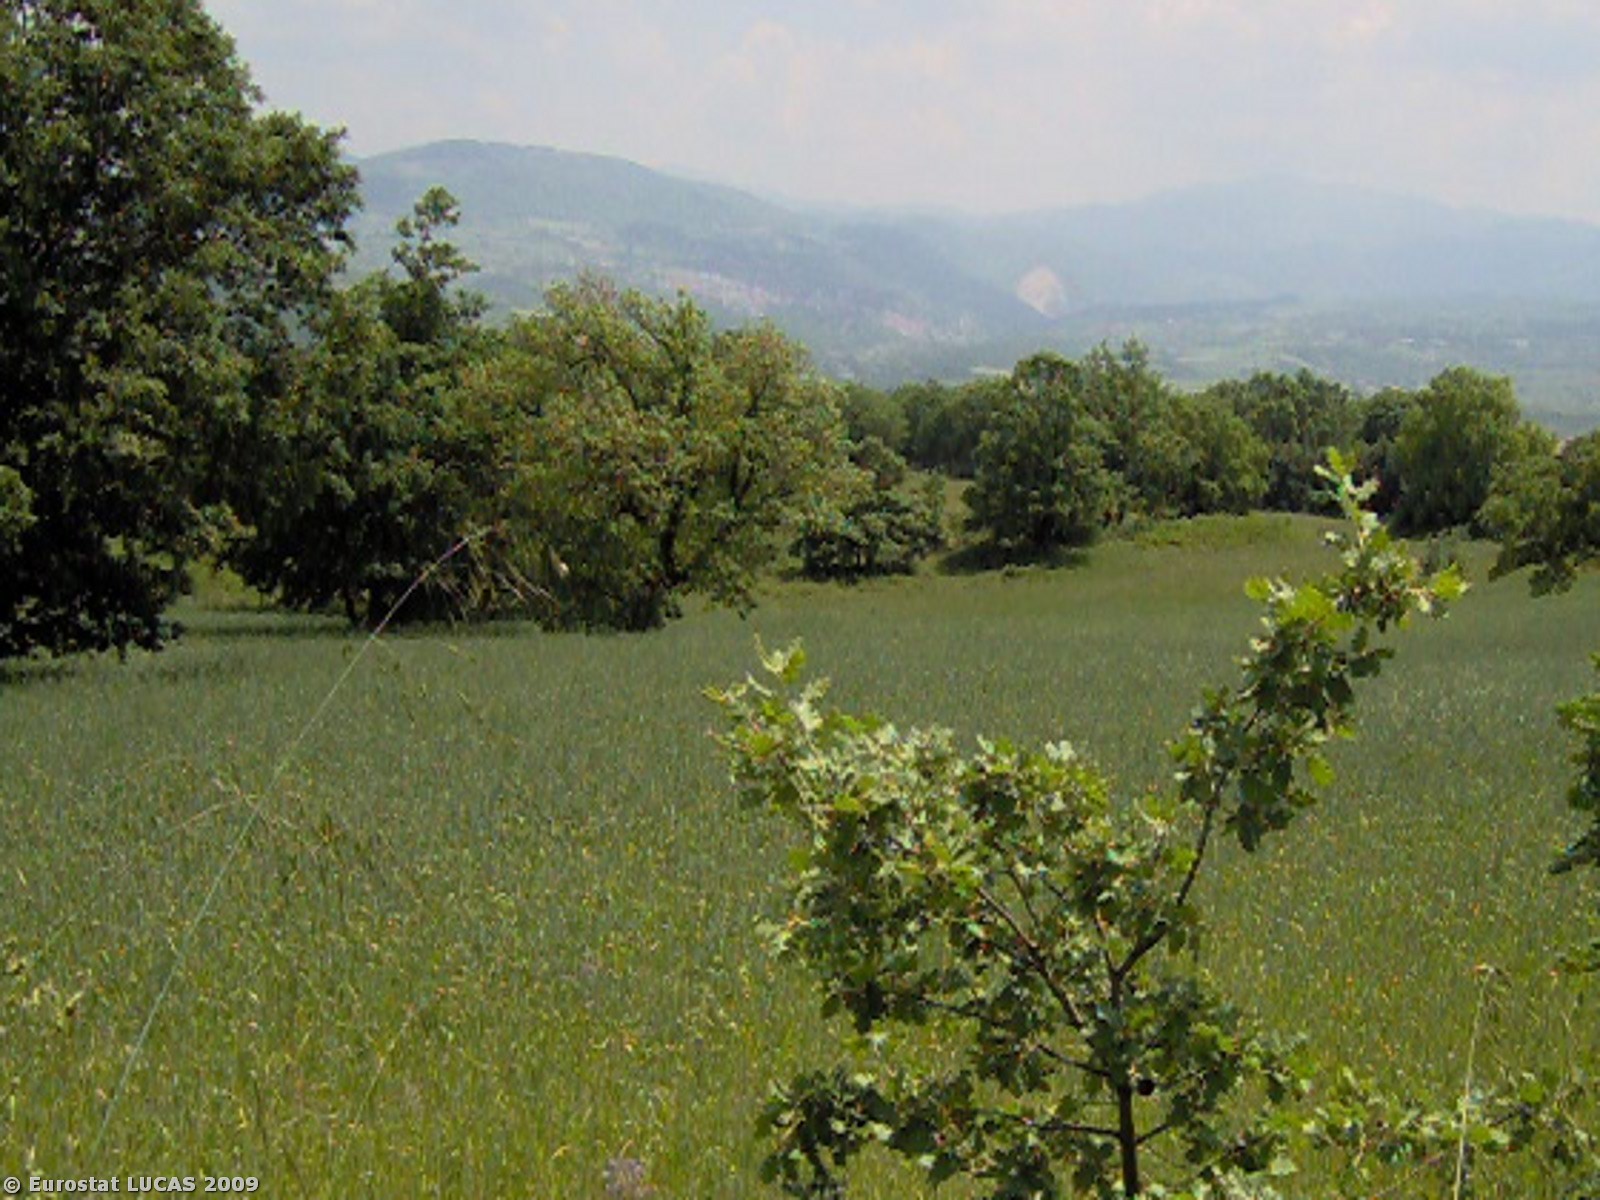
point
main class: Cropland
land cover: Mixed cereals for fodder
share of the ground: > 75 %
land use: Agriculture (excluding fallow land and kitchen gardens)
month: May
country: IT
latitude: 40.6142
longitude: 15.6159
